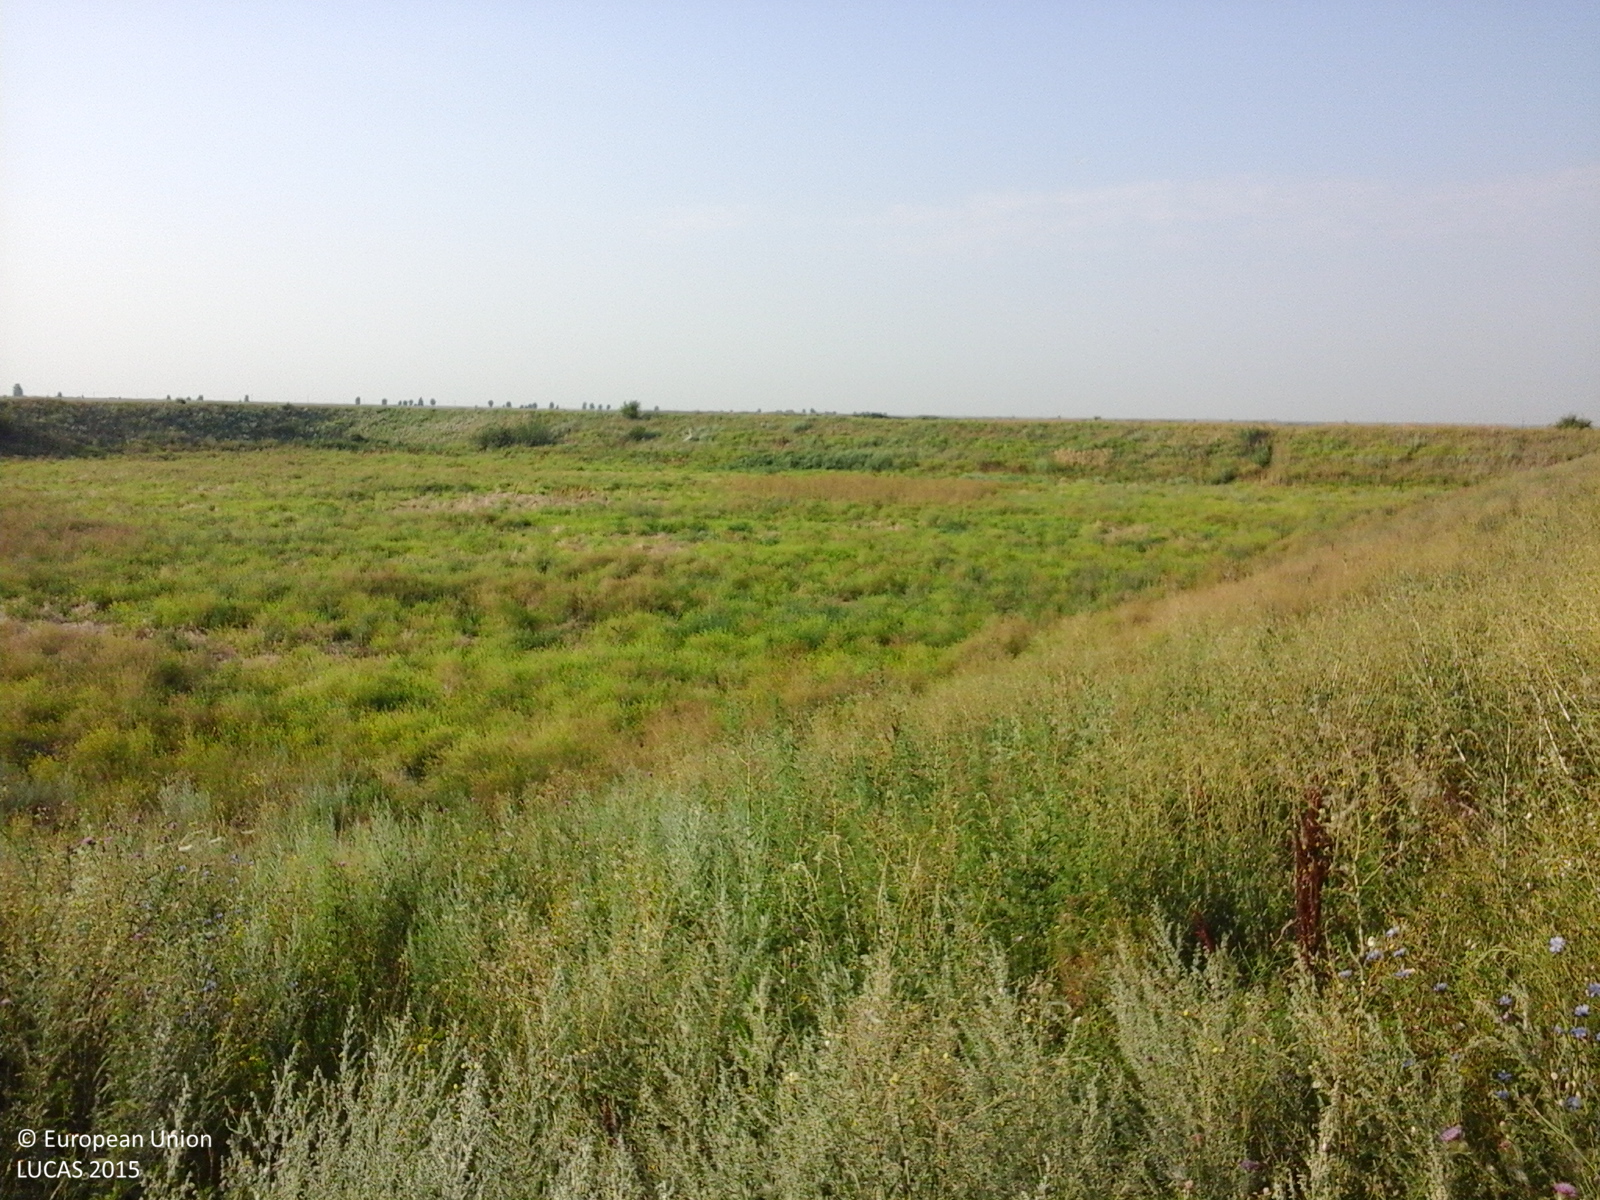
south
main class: Grassland
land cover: Spontaneously vegetated surfaces
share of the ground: > 75 %
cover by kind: herbaceous plants 100 %
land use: Fallow land
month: July
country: RO
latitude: 44.6536
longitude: 27.0678
